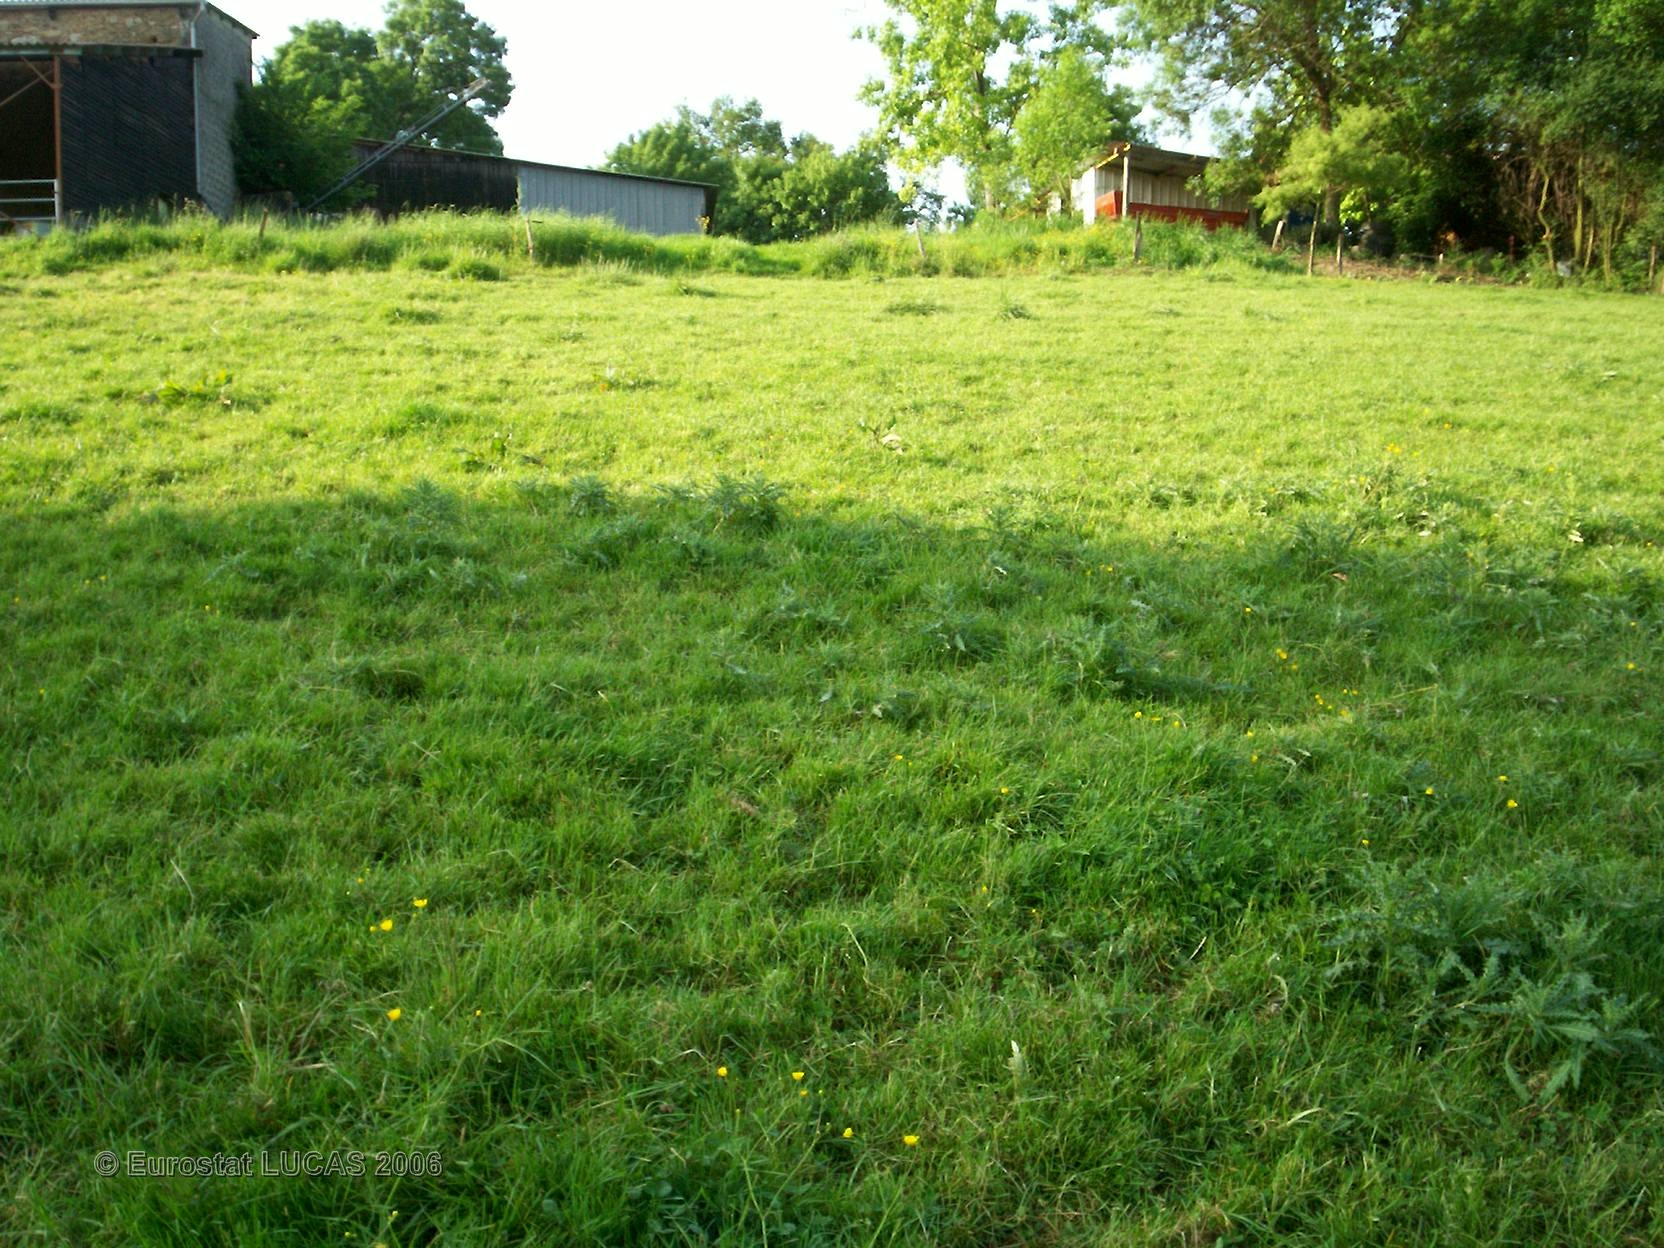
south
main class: Grassland
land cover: Grassland without tree/shrub cover
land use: Agriculture (excluding fallow land and kitchen gardens)
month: May
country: FR
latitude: 43.7938
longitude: 0.1885
